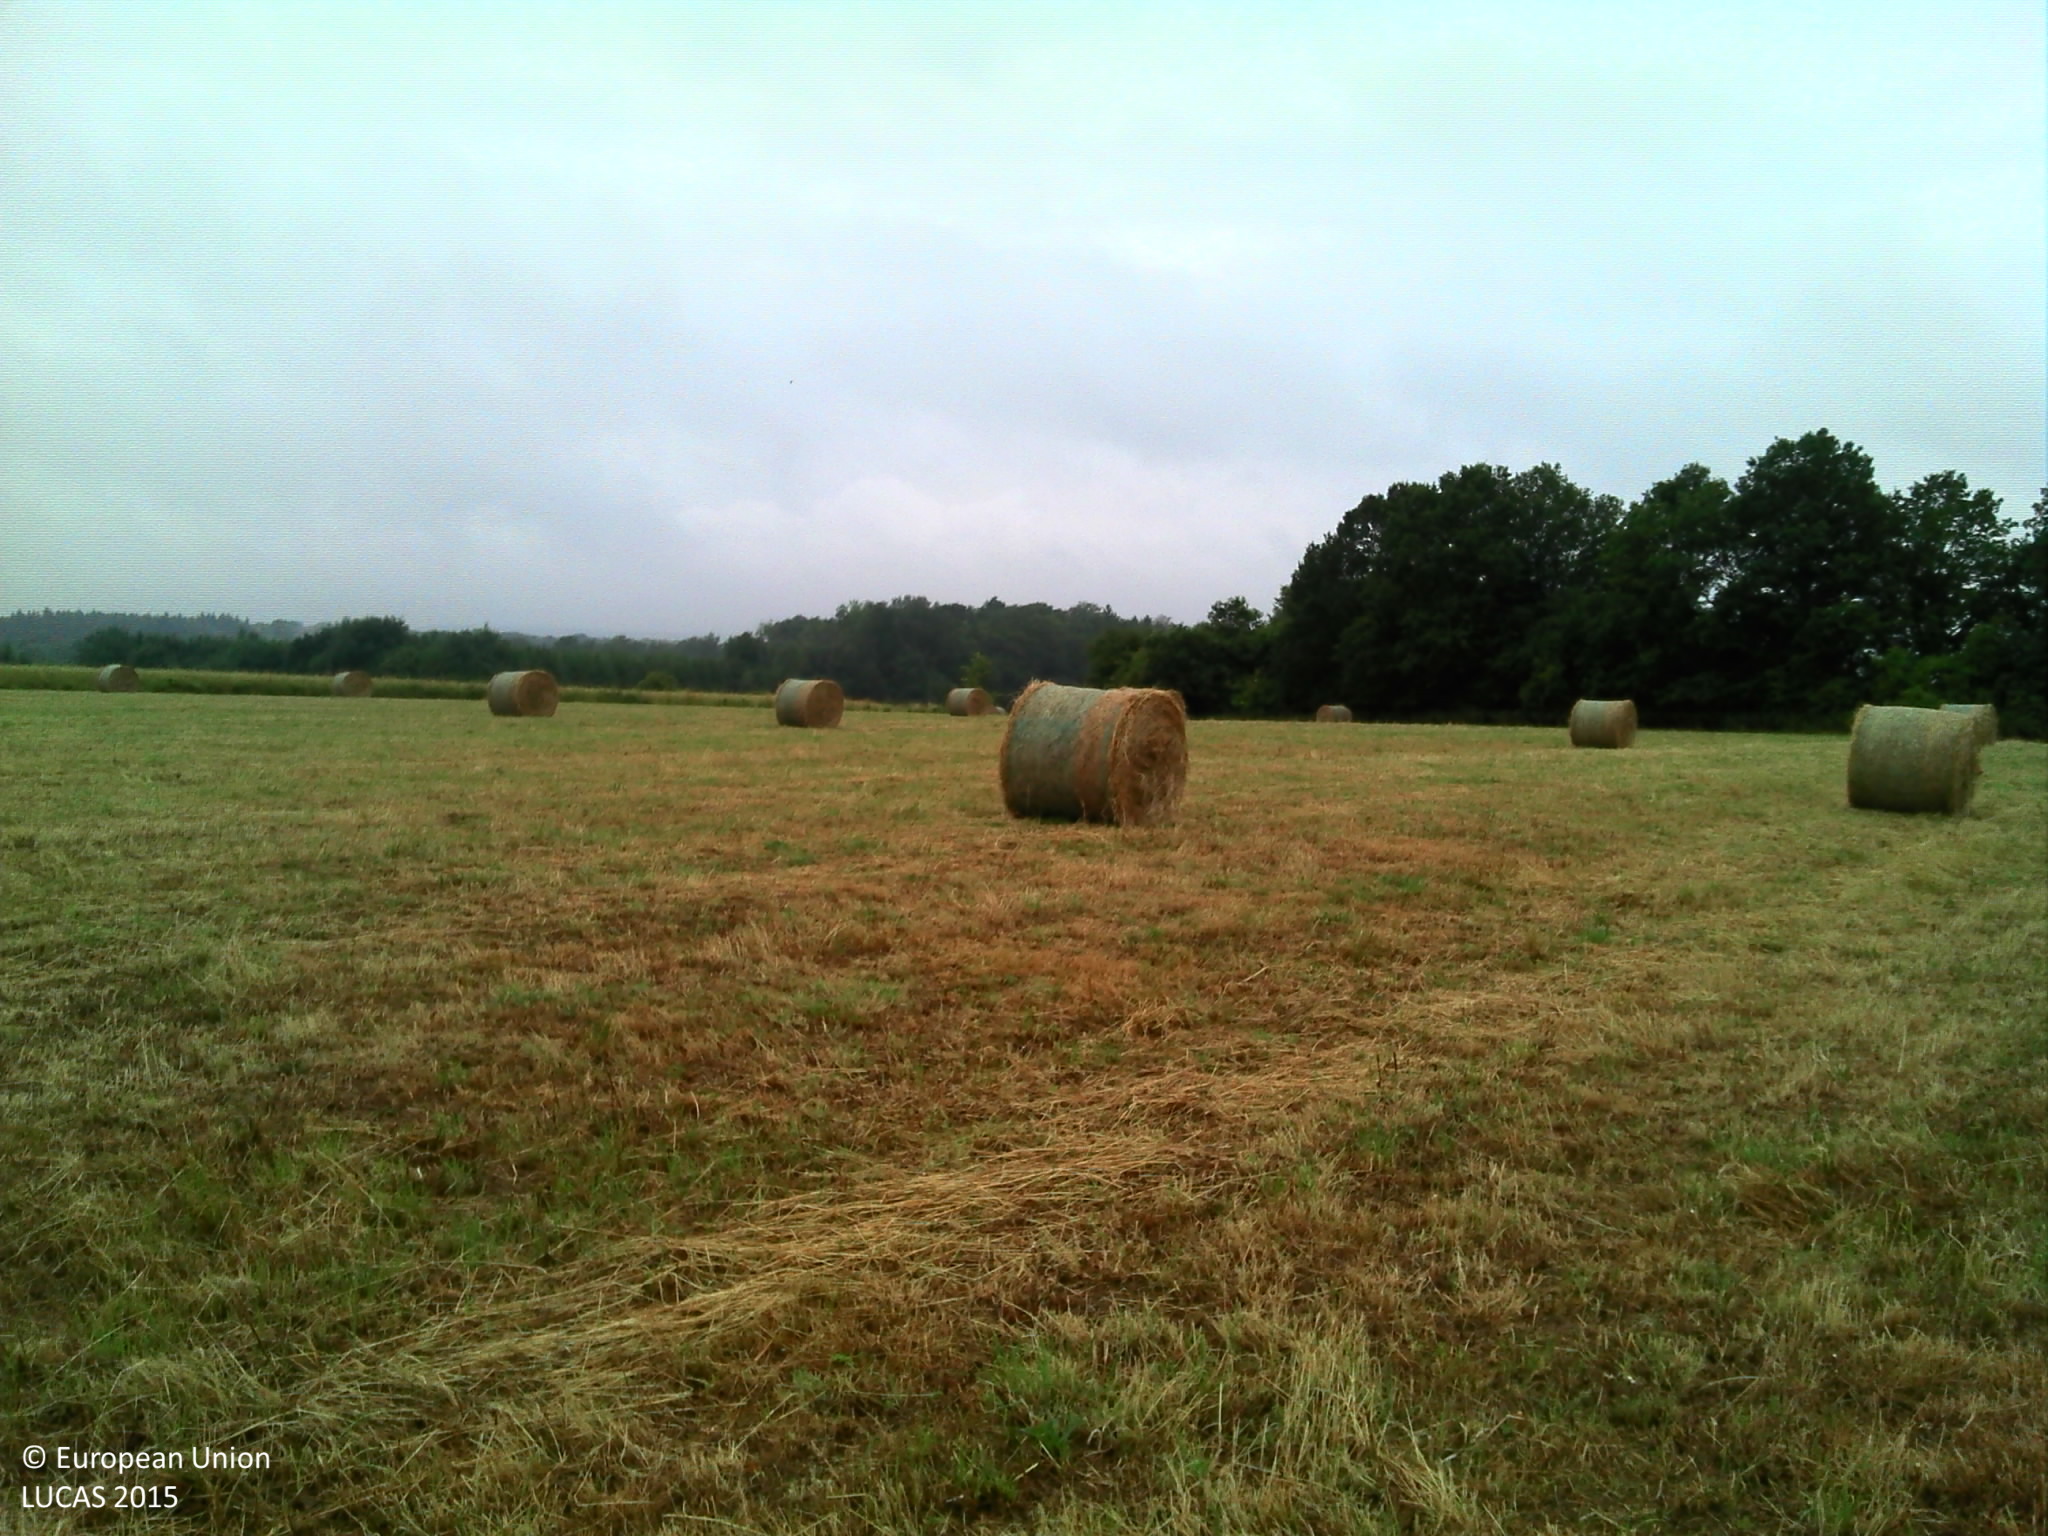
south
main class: Grassland
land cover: Grassland with sparse tree/shrub cover
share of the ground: > 75 %
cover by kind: herbaceous plants 95 %, broadleaved forest trees 5 %
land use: Agriculture (excluding fallow land and kitchen gardens)
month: July
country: BE
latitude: 49.7067
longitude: 5.2417
